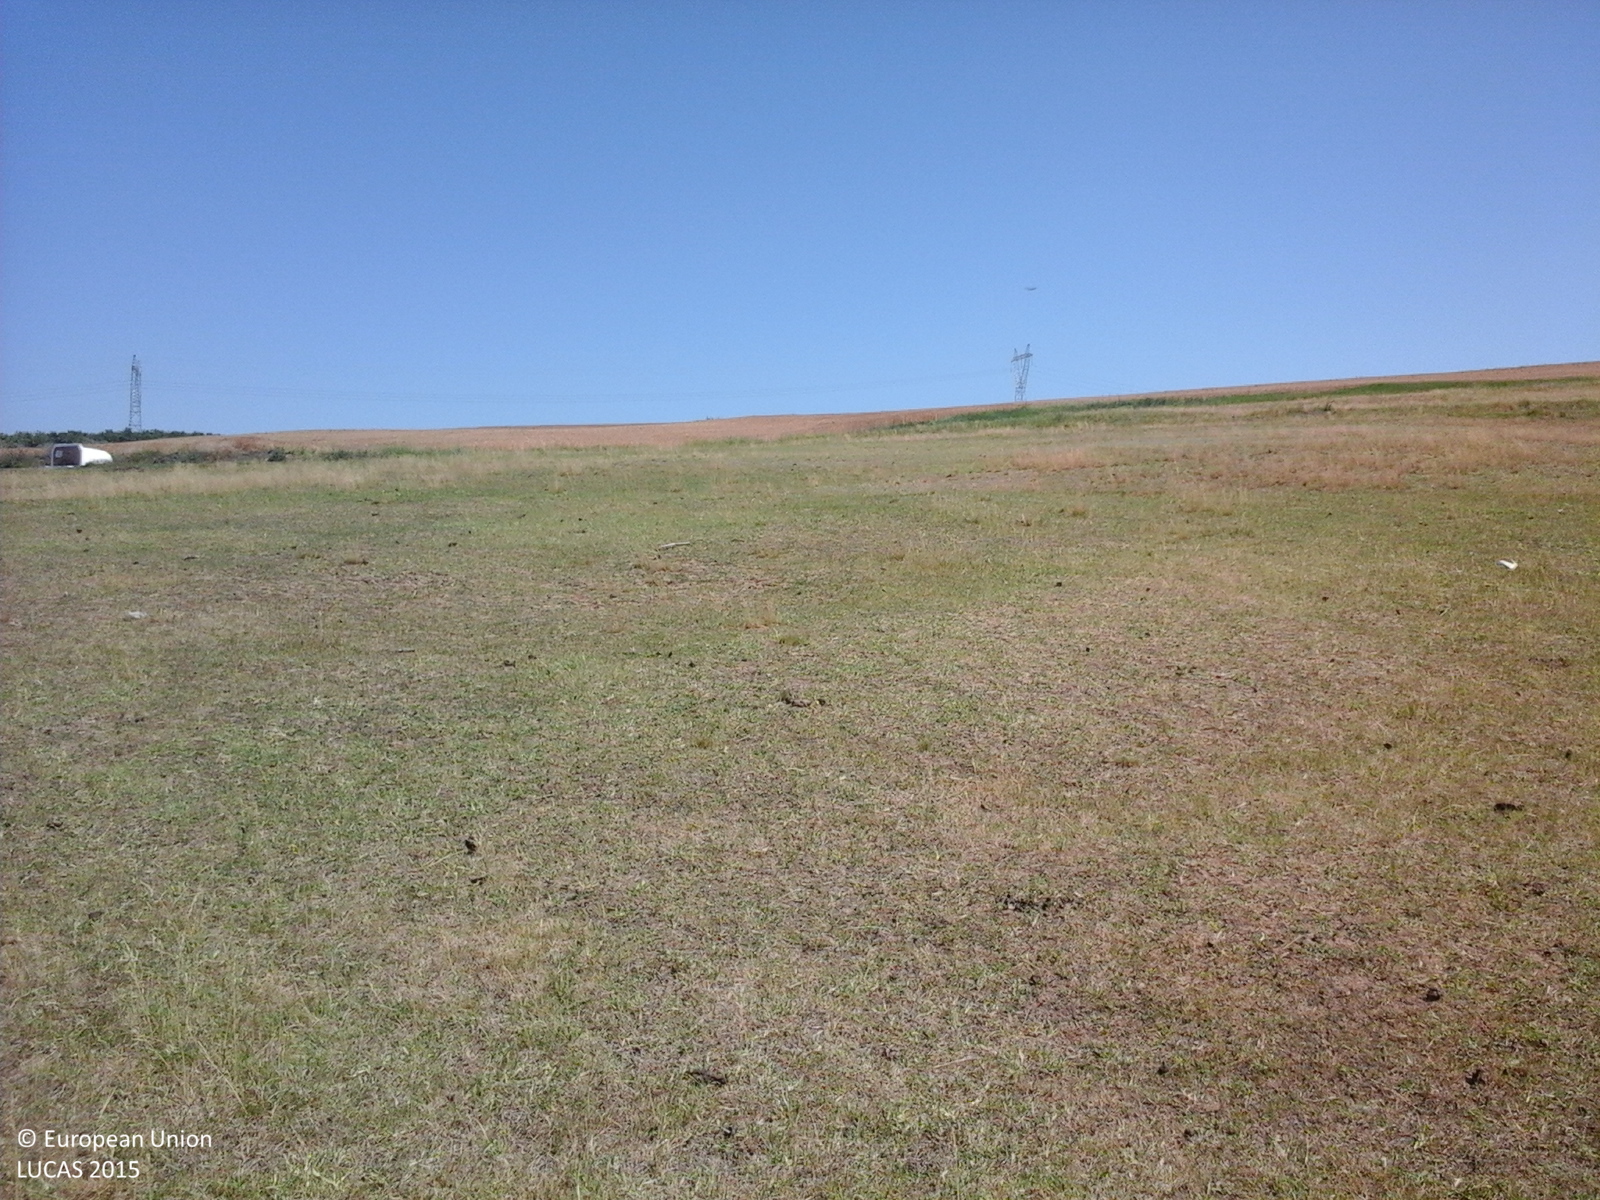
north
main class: Grassland
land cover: Grassland without tree/shrub cover
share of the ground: > 75 %
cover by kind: herbaceous plants 100 %
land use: Agriculture (excluding fallow land and kitchen gardens)
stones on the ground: 10 - 25 %
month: June
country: RO
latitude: 47.2440
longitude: 26.9713
